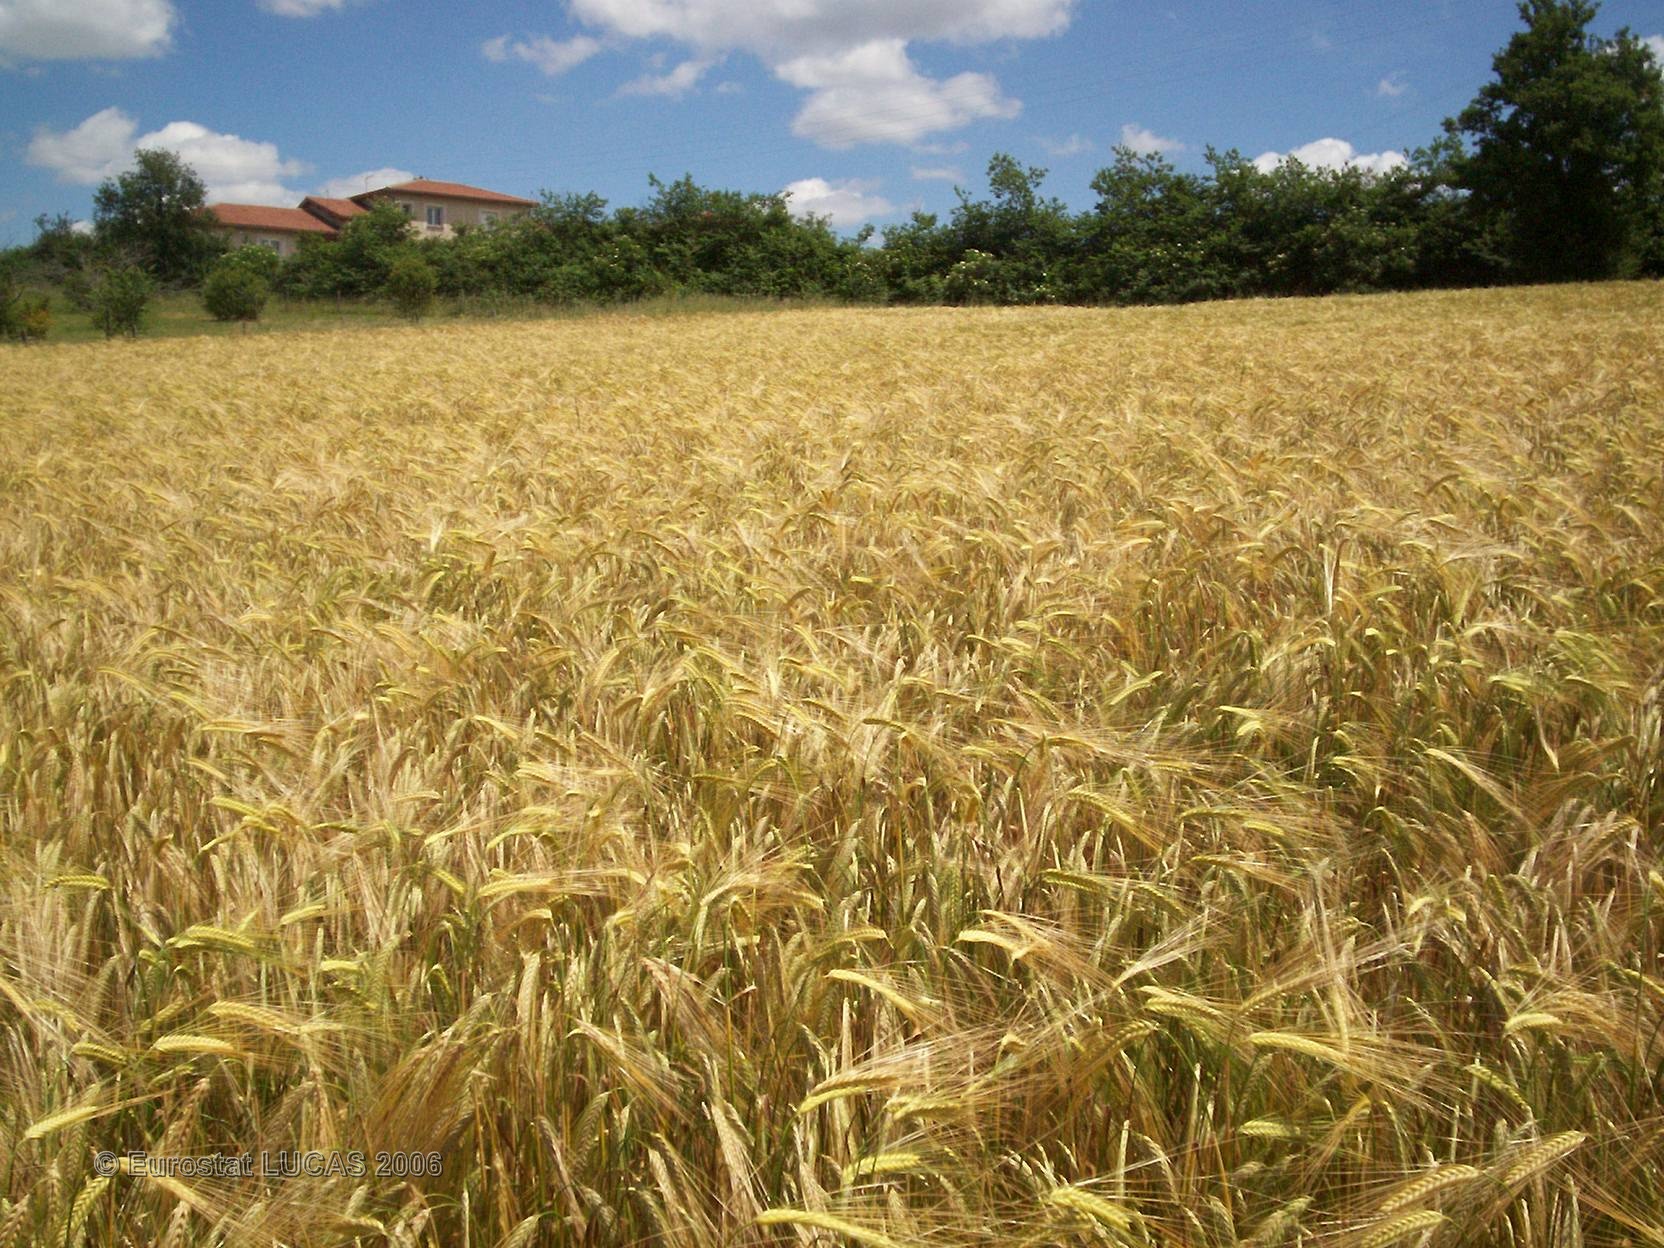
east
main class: Cropland
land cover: Barley
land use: Agriculture (excluding fallow land and kitchen gardens)
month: May
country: FR
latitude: 43.4681
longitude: 0.9900
